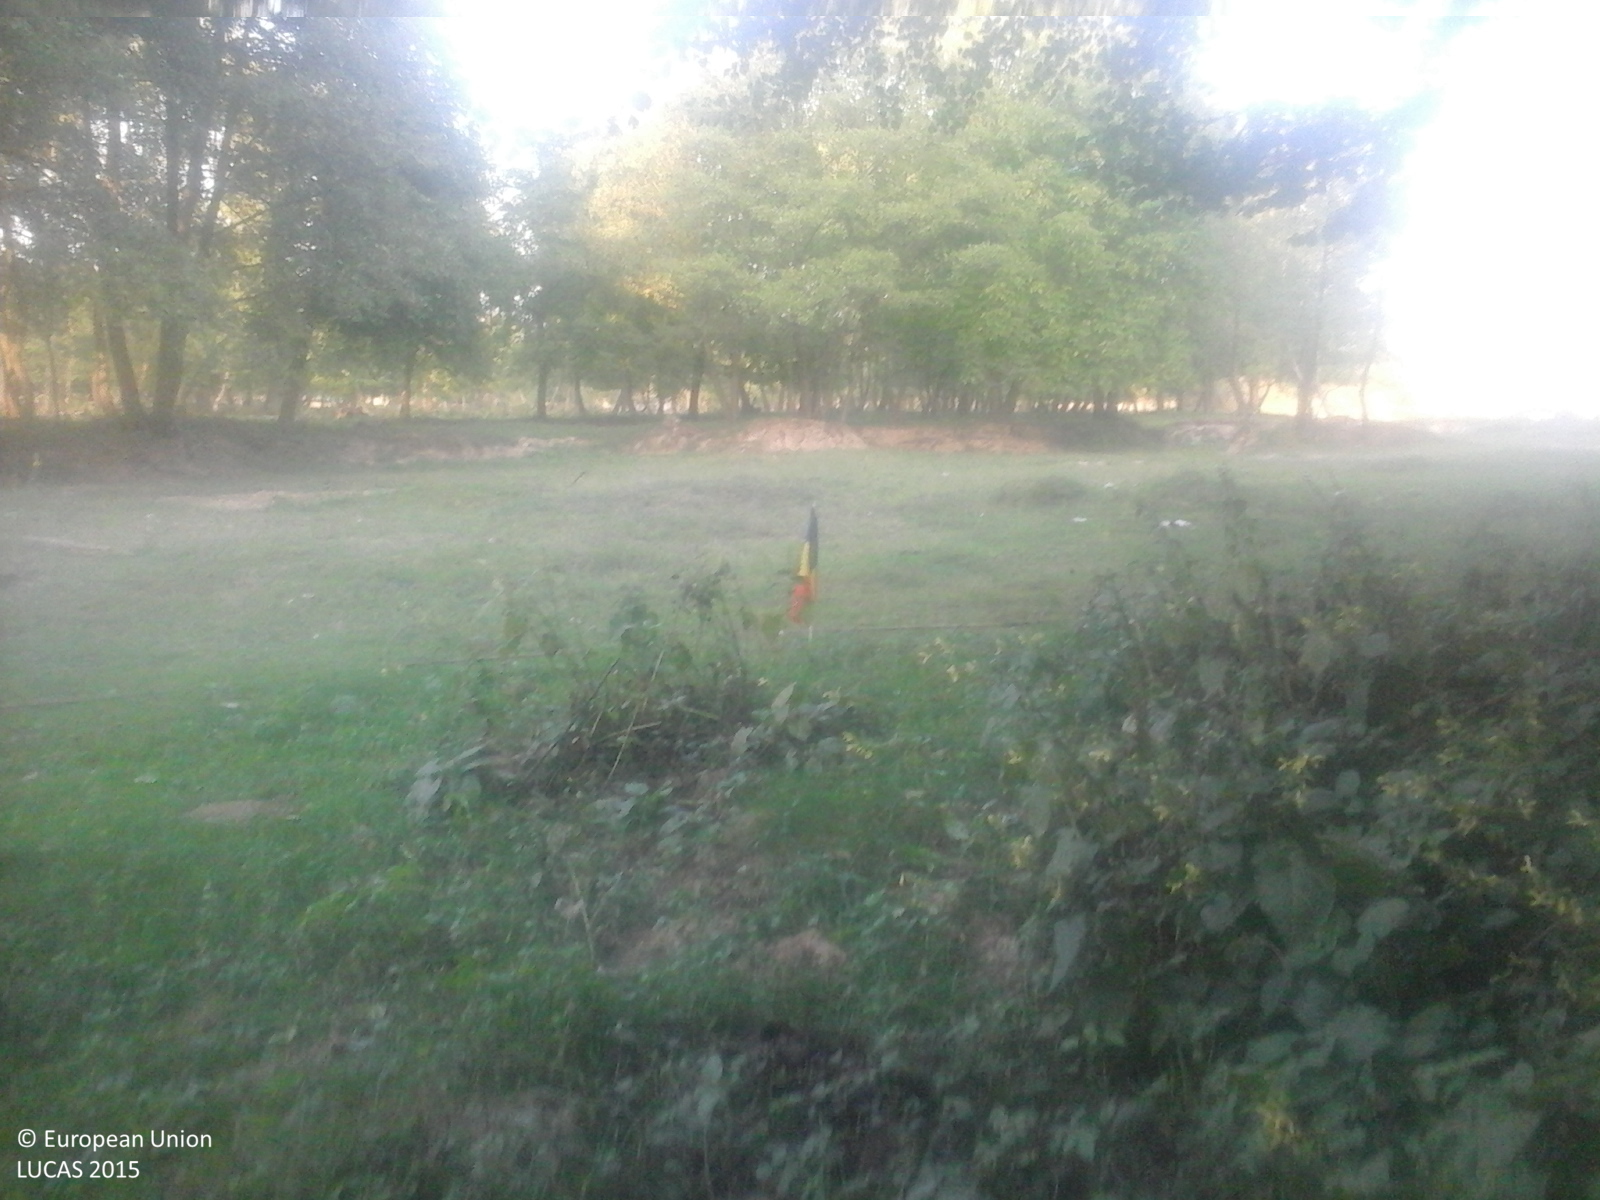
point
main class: Grassland
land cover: Grassland without tree/shrub cover
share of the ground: > 75 %
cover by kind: herbaceous plants 100 %
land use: Agriculture (excluding fallow land and kitchen gardens)
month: September
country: RO
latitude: 46.6259
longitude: 22.4192
